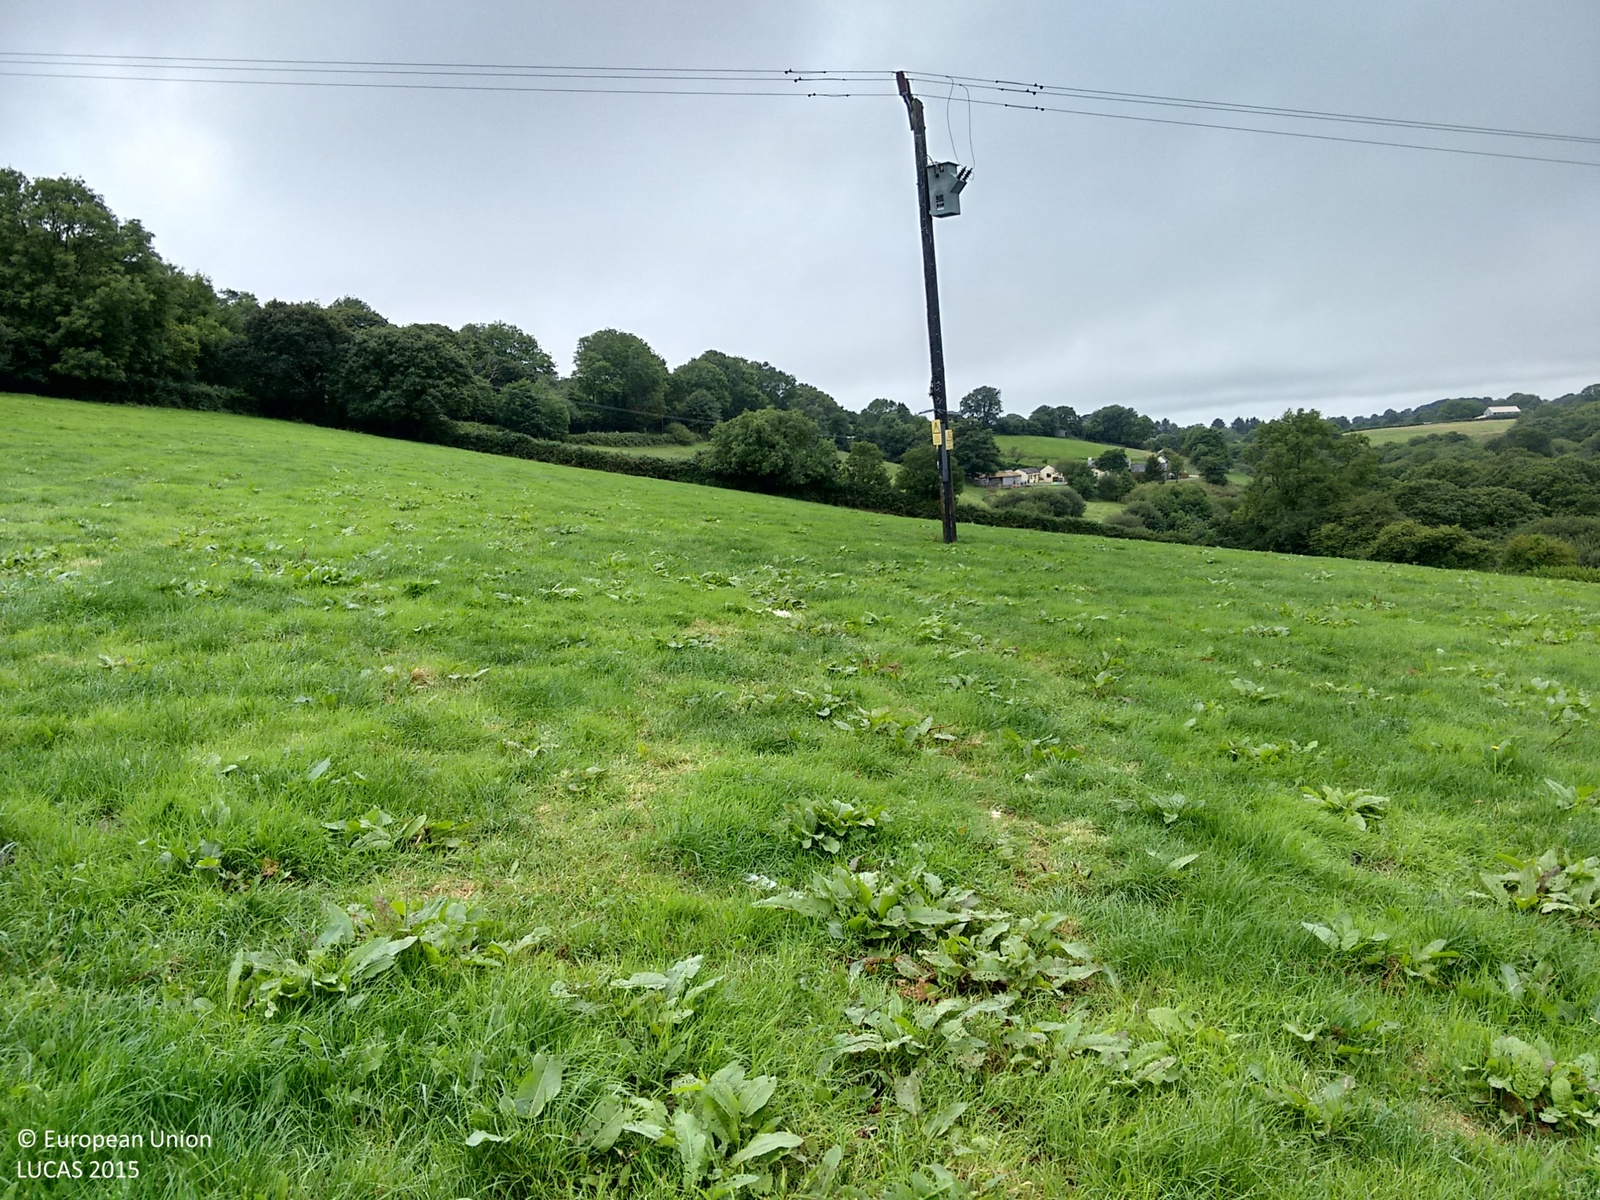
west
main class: Grassland
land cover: Grassland without tree/shrub cover
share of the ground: > 75 %
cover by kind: herbaceous plants 100 %
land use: Agriculture (excluding fallow land and kitchen gardens)
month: August
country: GB
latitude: 51.7098
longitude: -4.7128
